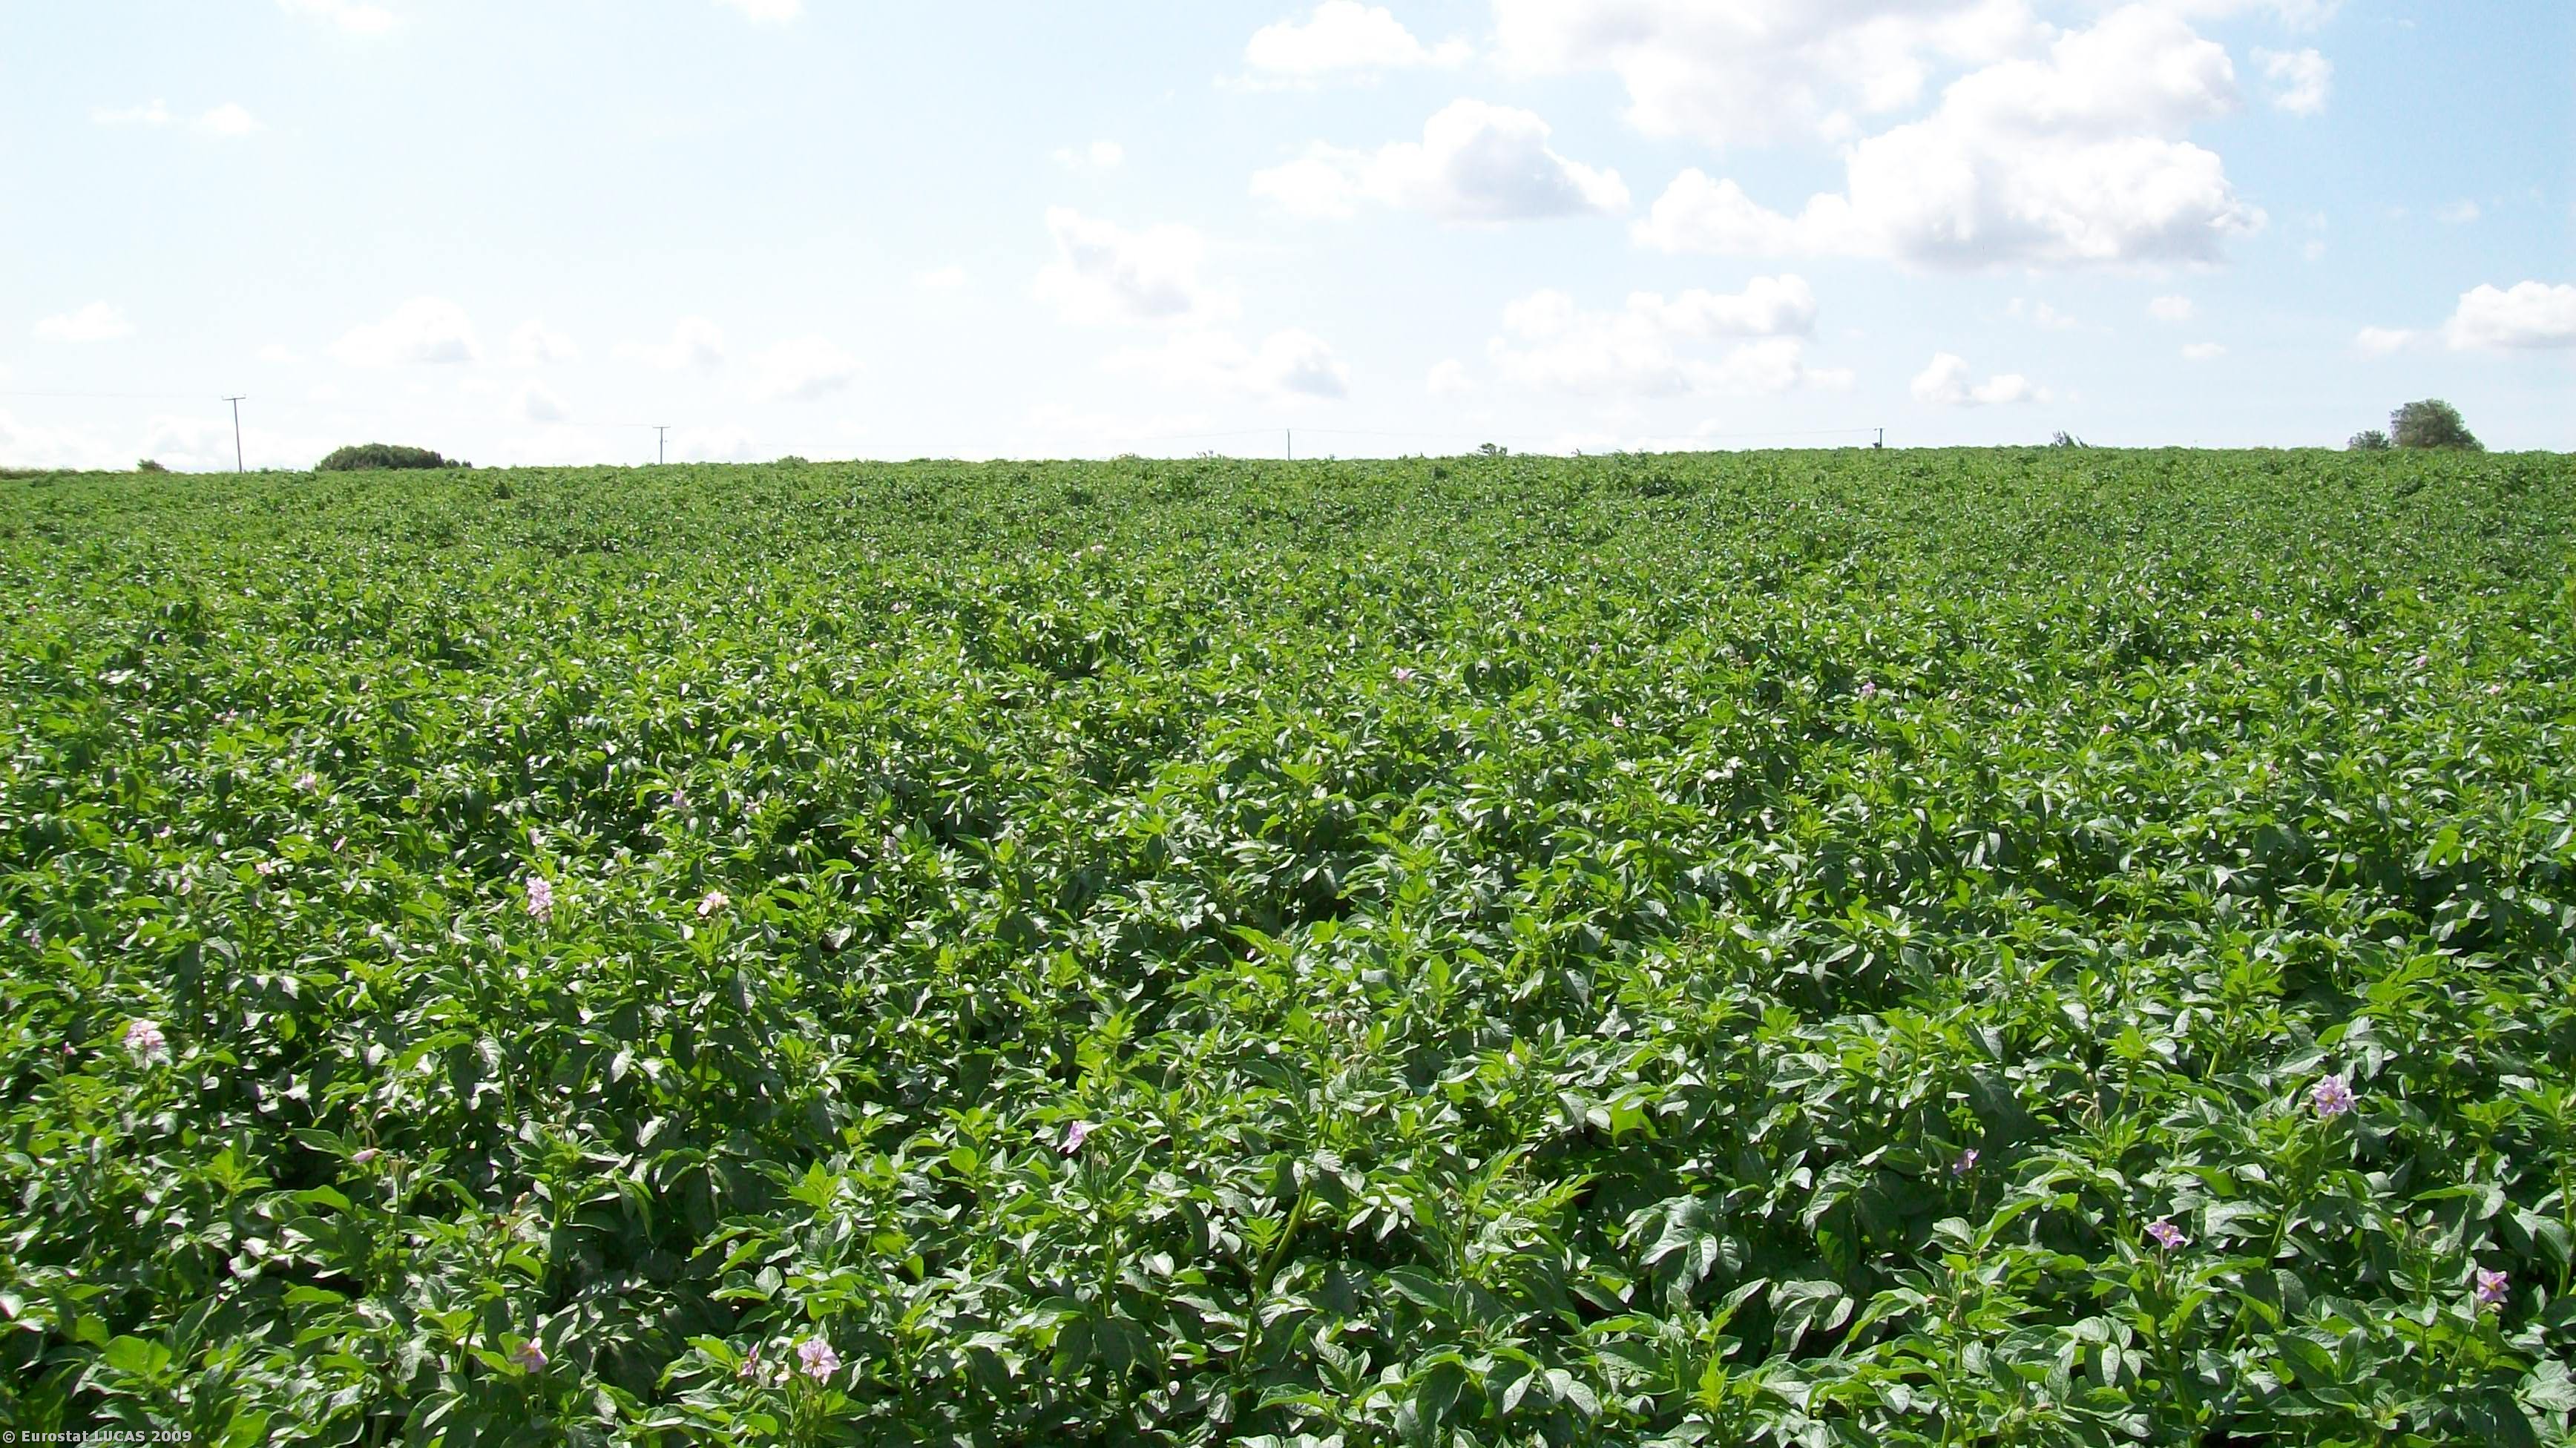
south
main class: Cropland
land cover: Potatoes
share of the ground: > 75 %
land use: Agriculture (excluding fallow land and kitchen gardens)
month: July
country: GB
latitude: 54.0406
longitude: -0.4040
